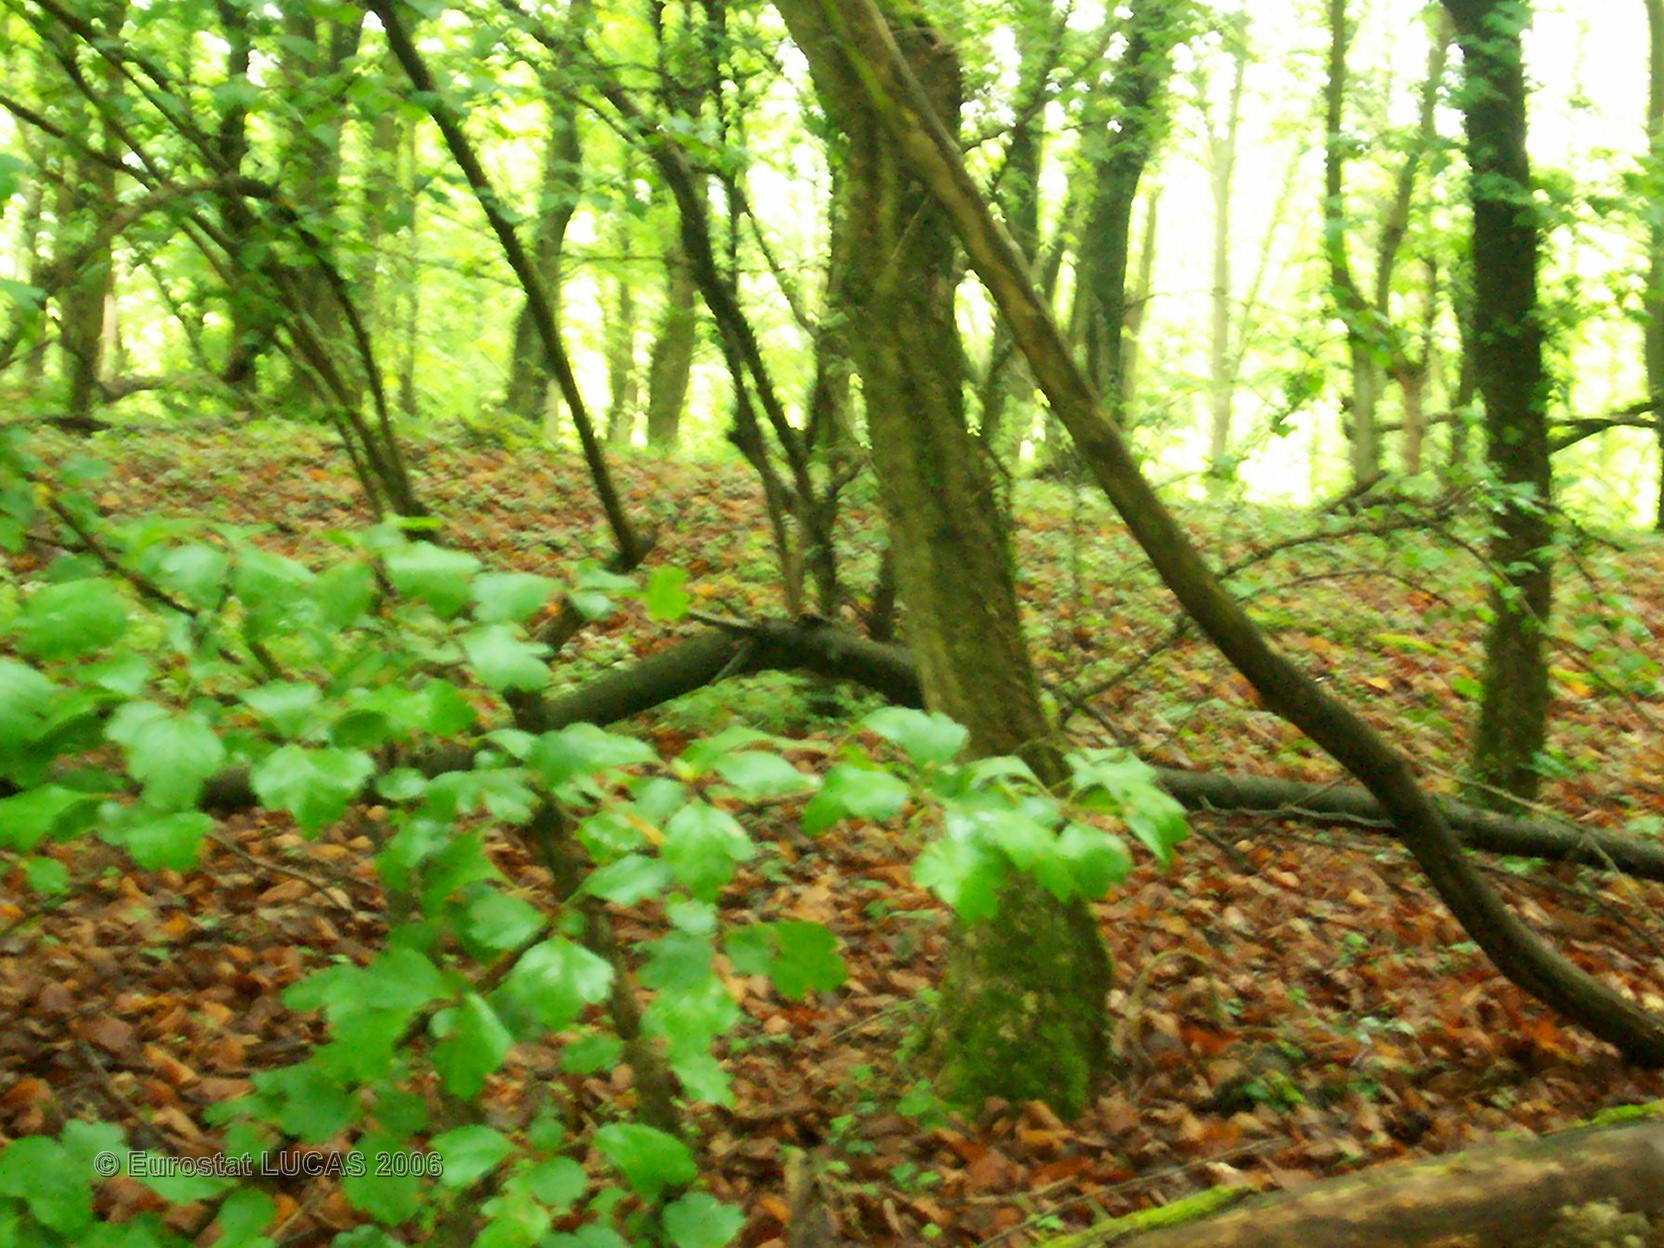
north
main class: Woodland
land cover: Broadleaved forest
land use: Forestry
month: May
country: FR
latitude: 49.3176
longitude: 6.4093
